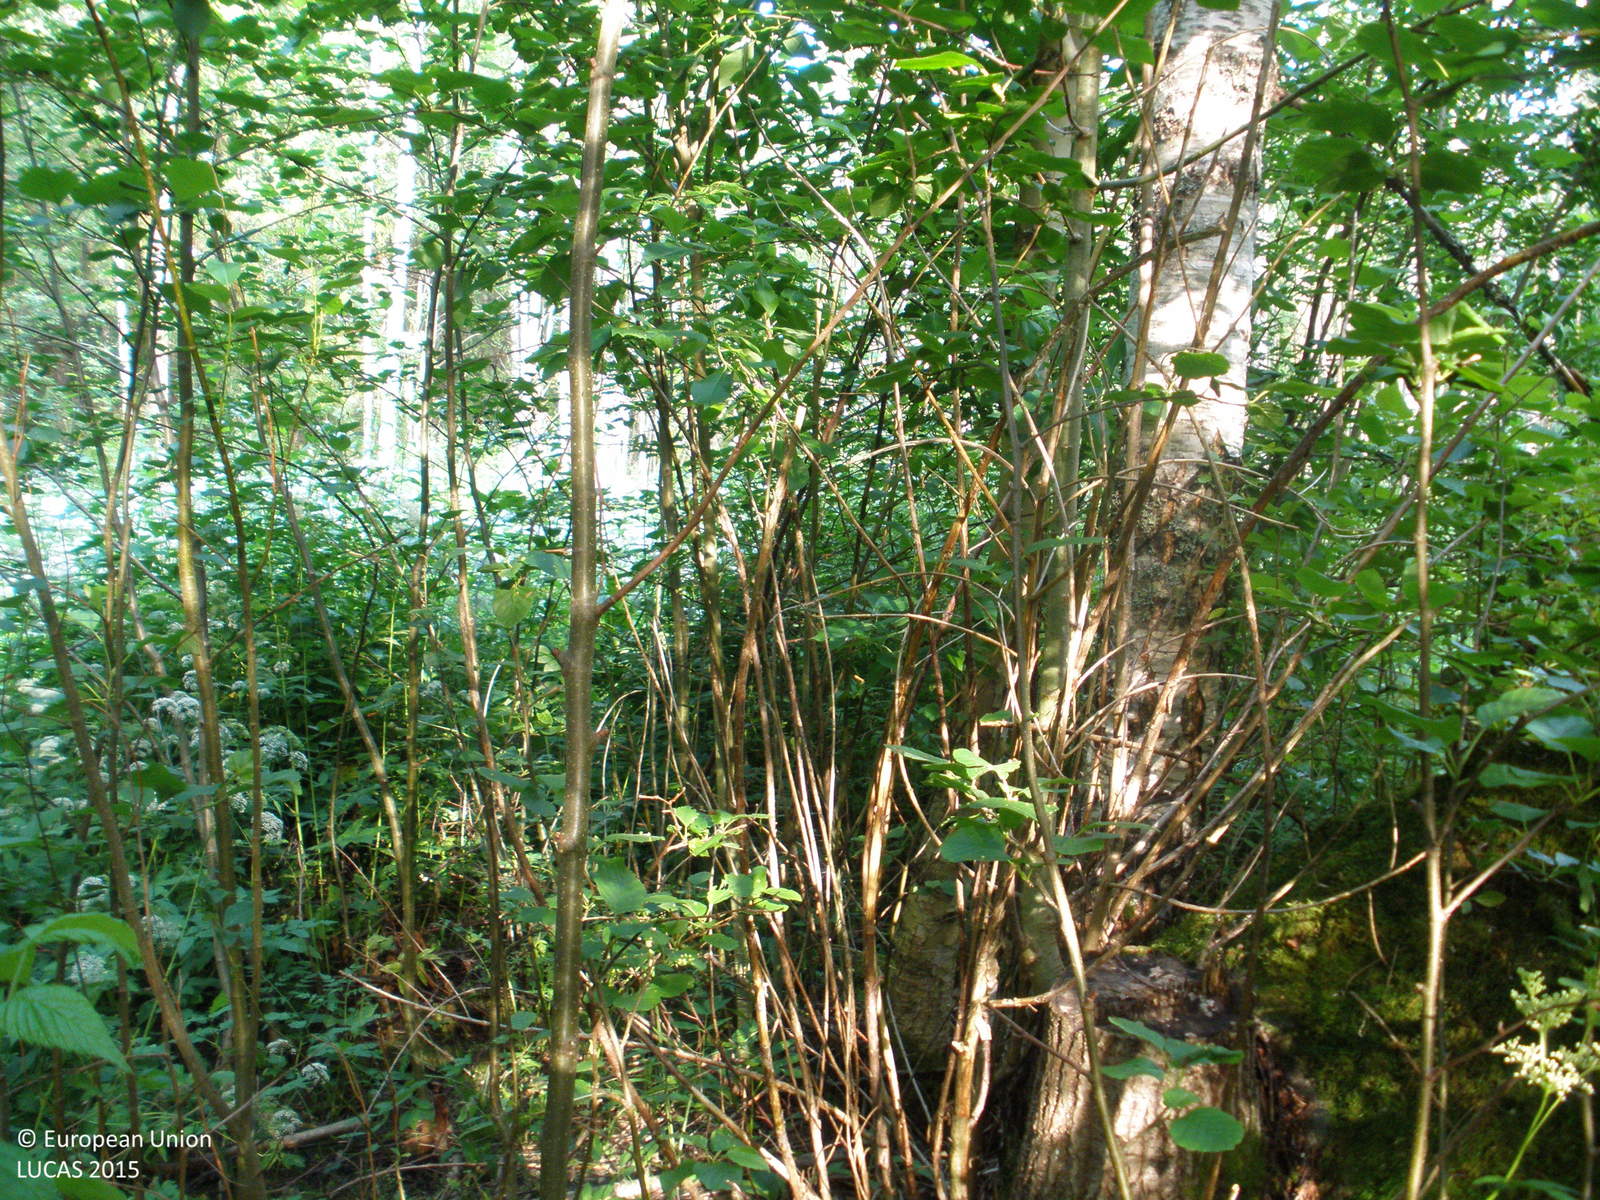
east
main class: Woodland
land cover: Broadleaved woodland
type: non-riverine alder, birch or aspen forest
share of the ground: > 75 %
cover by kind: broadleaved forest trees 85 %, shrubs 10 %, herbaceous plants 5 %
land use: Forestry
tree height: > 5 m
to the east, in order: Broadleaved woodland; Electric lines; Broadleaved woodland; Shrubland without tree cover; Ditches and canals; Spruce dominated mixed woodland; Pine dominated mixed woodland; Tracks; Spruce dominated mixed woodland; Ditches and canals; Broadleaved woodland; Ditches and canals; Broadleaved woodland; Ditches and canals; Broadleaved woodland
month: July
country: FI
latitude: 61.4027
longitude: 24.0045
